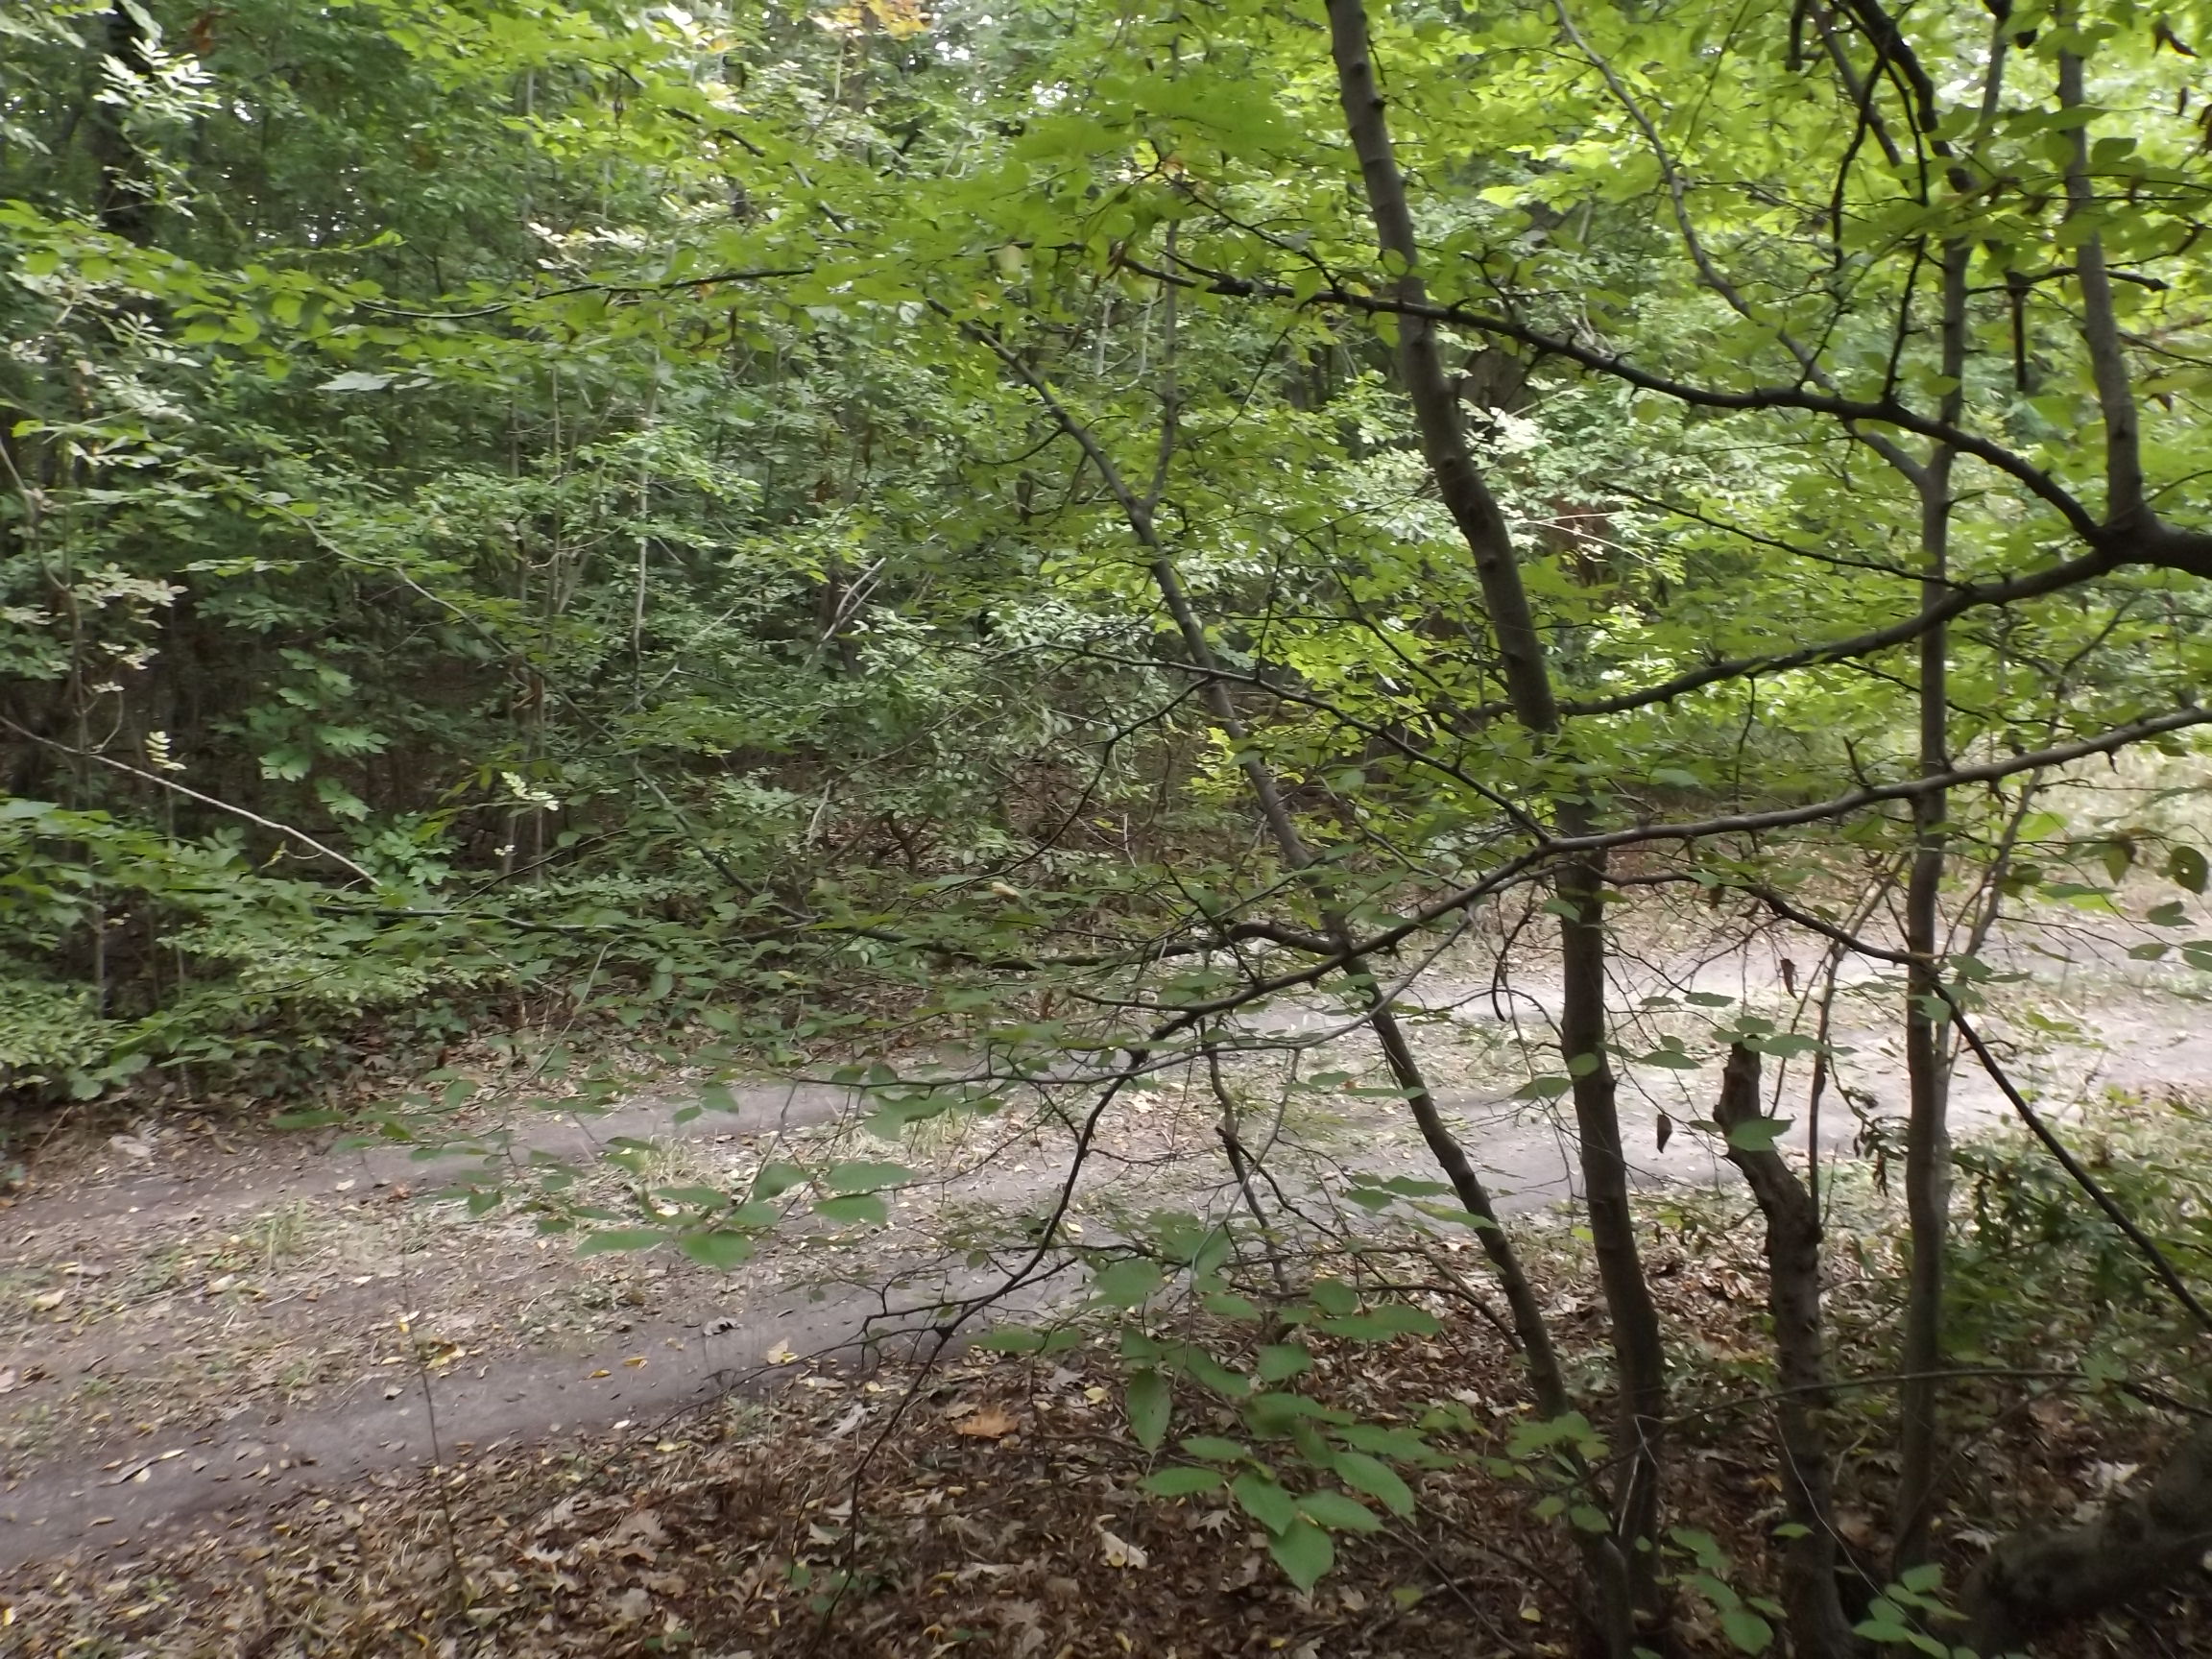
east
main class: Woodland
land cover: Broadleaved woodland
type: beech forest
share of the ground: > 75 %
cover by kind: broadleaved forest trees 100 %
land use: Forestry
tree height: > 5 m
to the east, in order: Broadleaved woodland; Tracks; Broadleaved woodland; Paved roads, cycling and walking lanes; Broadleaved woodland; Electric lines; Broadleaved woodland
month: October
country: BG
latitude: 42.9455
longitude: 27.8938
